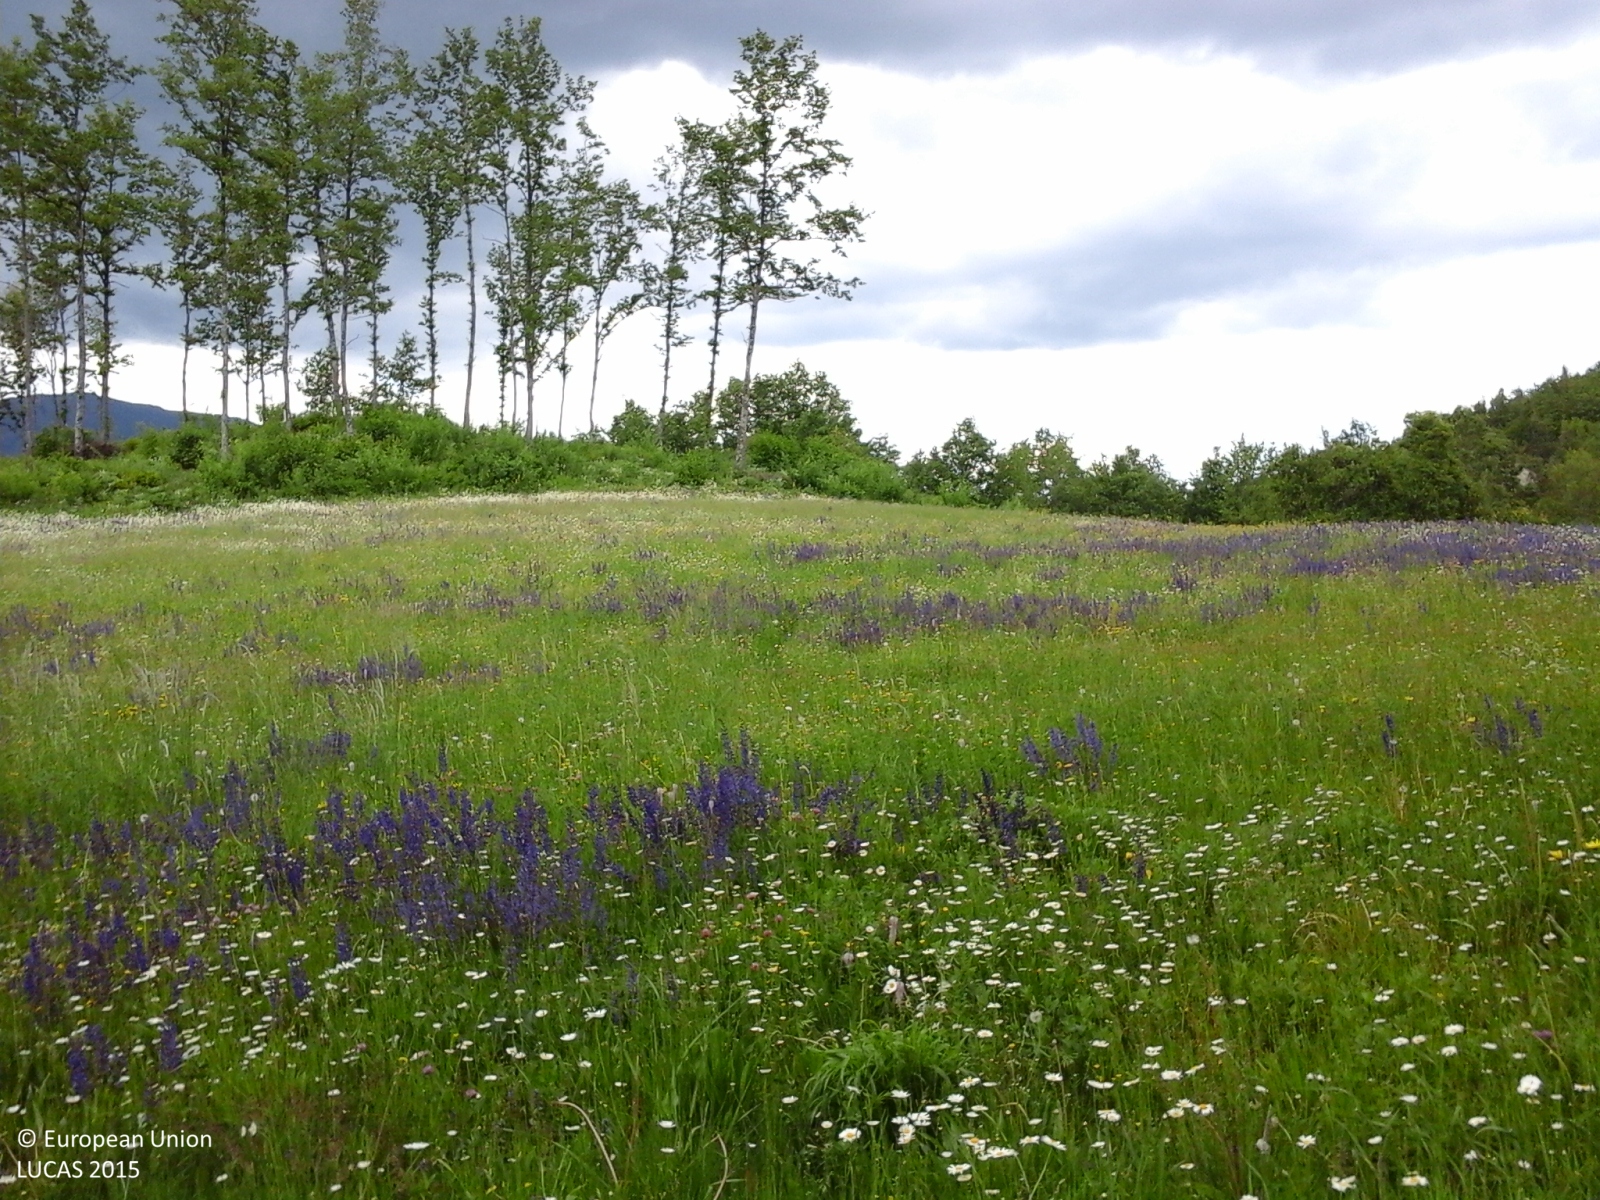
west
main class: Woodland
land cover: Broadleaved woodland
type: thermophilous deciduous forest
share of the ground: > 75 %
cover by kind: broadleaved forest trees 100 %
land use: Forestry
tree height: > 5 m
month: May
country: IT
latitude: 44.4587
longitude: 10.1129
